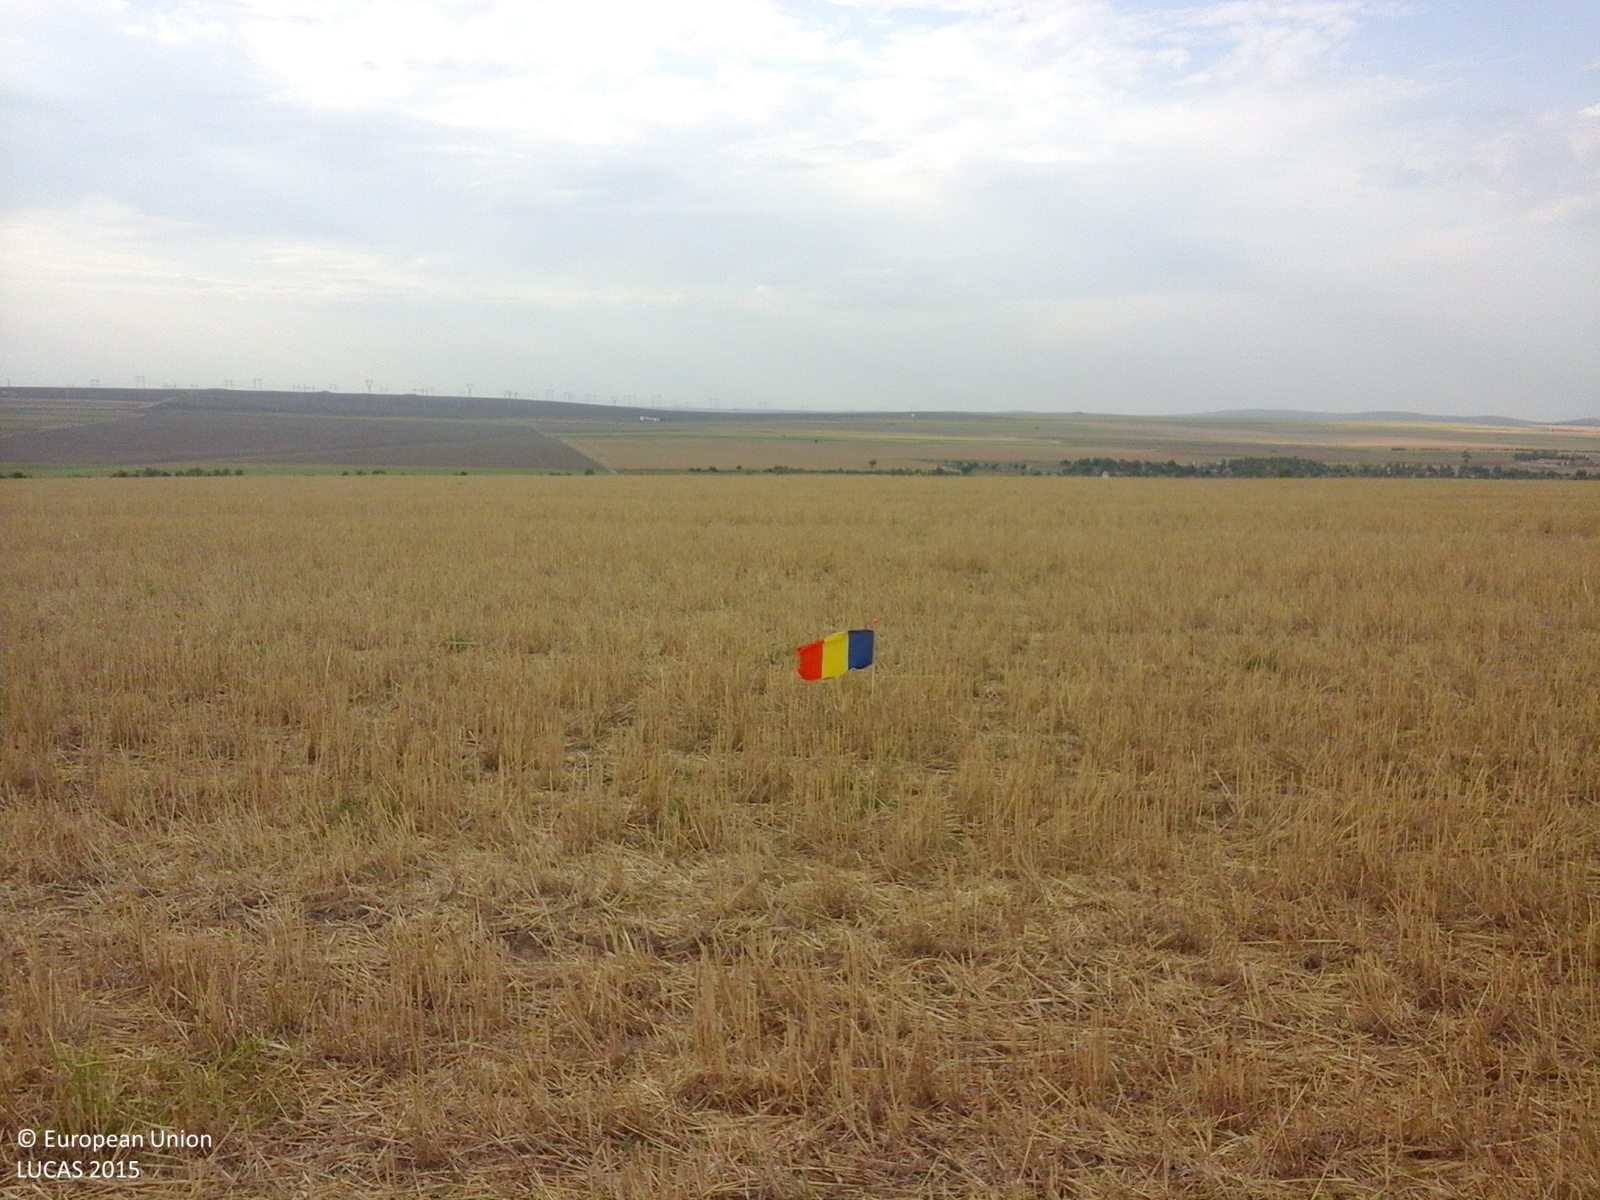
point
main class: Cropland
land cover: Common wheat
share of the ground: > 75 %
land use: Agriculture (excluding fallow land and kitchen gardens)
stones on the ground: < 10 %
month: August
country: RO
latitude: 44.3894
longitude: 28.1760
